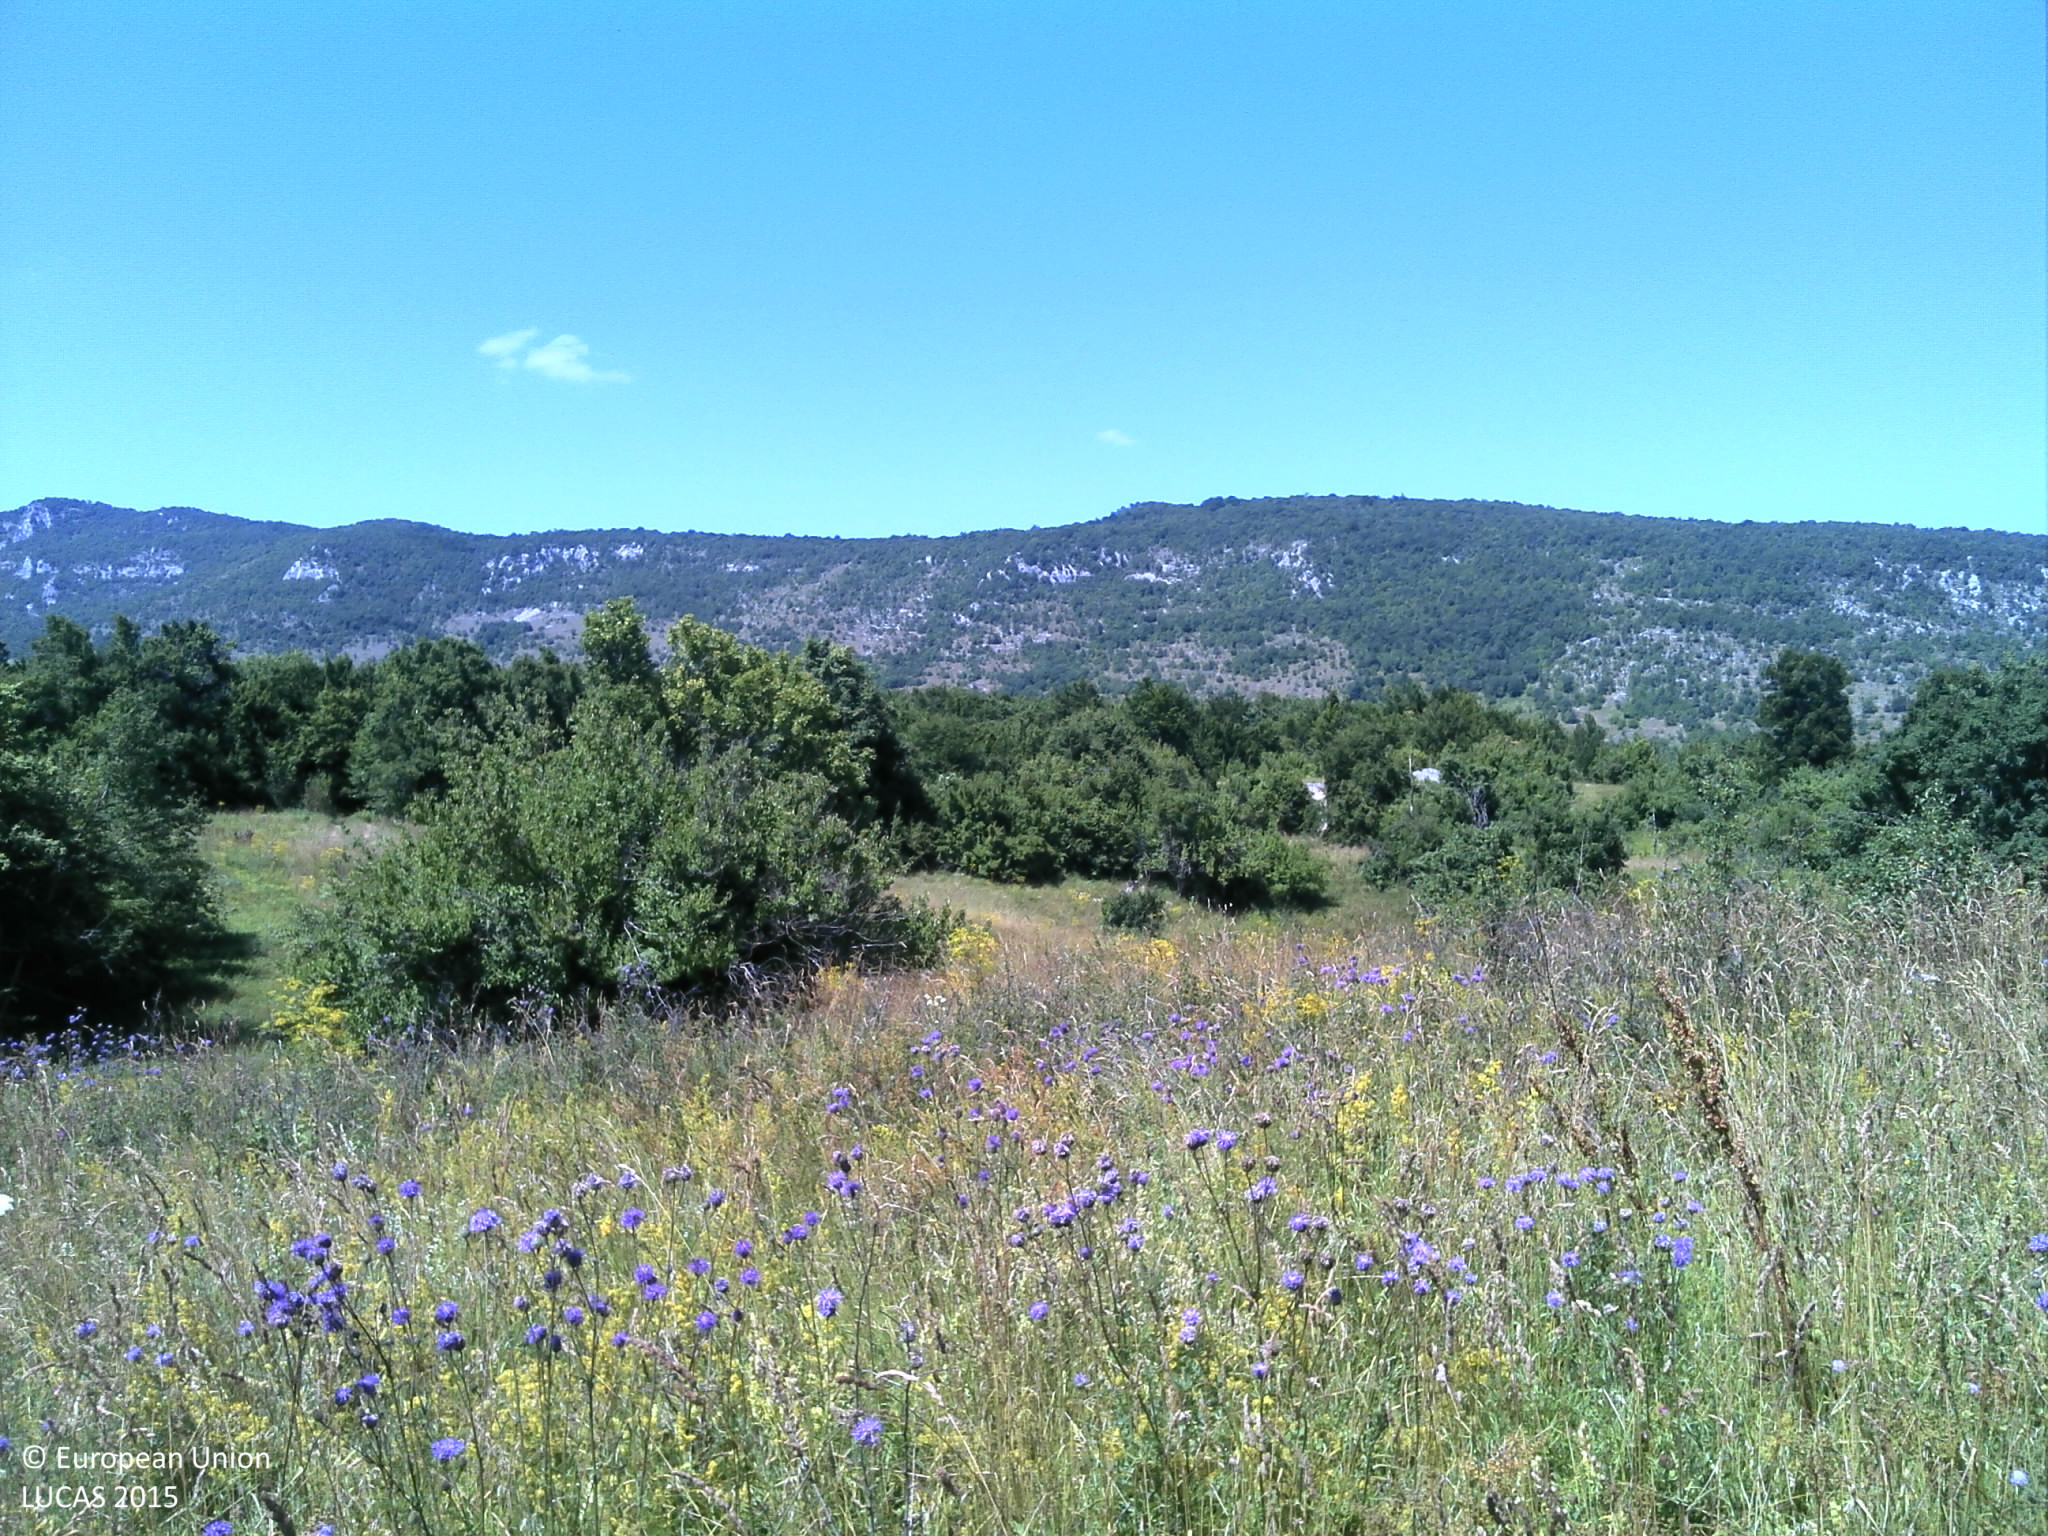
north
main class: Grassland
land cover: Grassland without tree/shrub cover
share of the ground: > 75 %
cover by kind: herbaceous plants 95 %, shrubs 5 %
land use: Semi-natural and natural areas not in use
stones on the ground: < 10 %
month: July
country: HR
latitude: 44.9247
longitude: 15.2014
